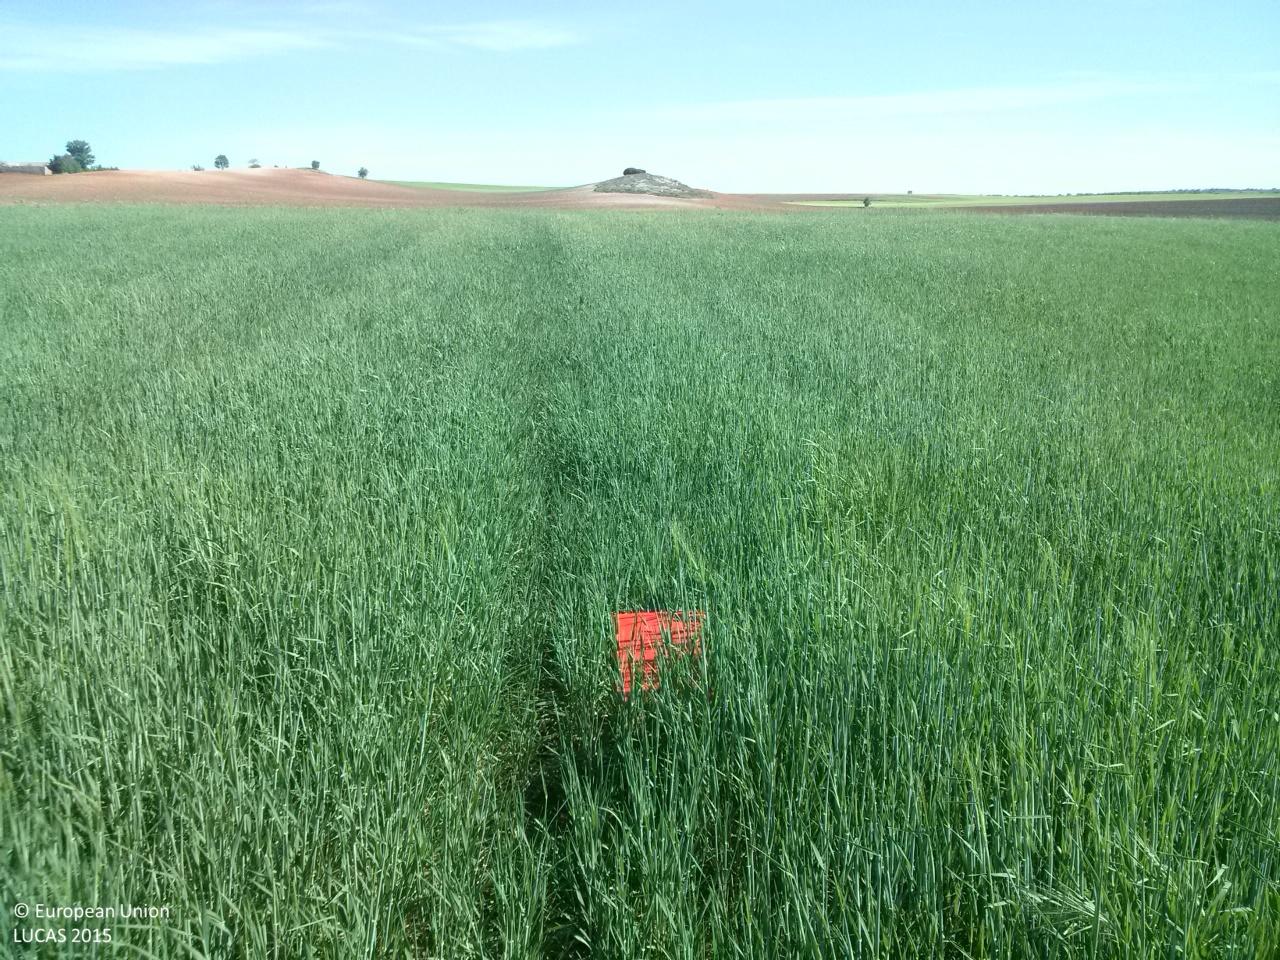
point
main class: Cropland
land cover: Barley
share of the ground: > 75 %
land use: Agriculture (excluding fallow land and kitchen gardens)
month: May
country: ES
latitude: 39.7994
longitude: -2.7369
